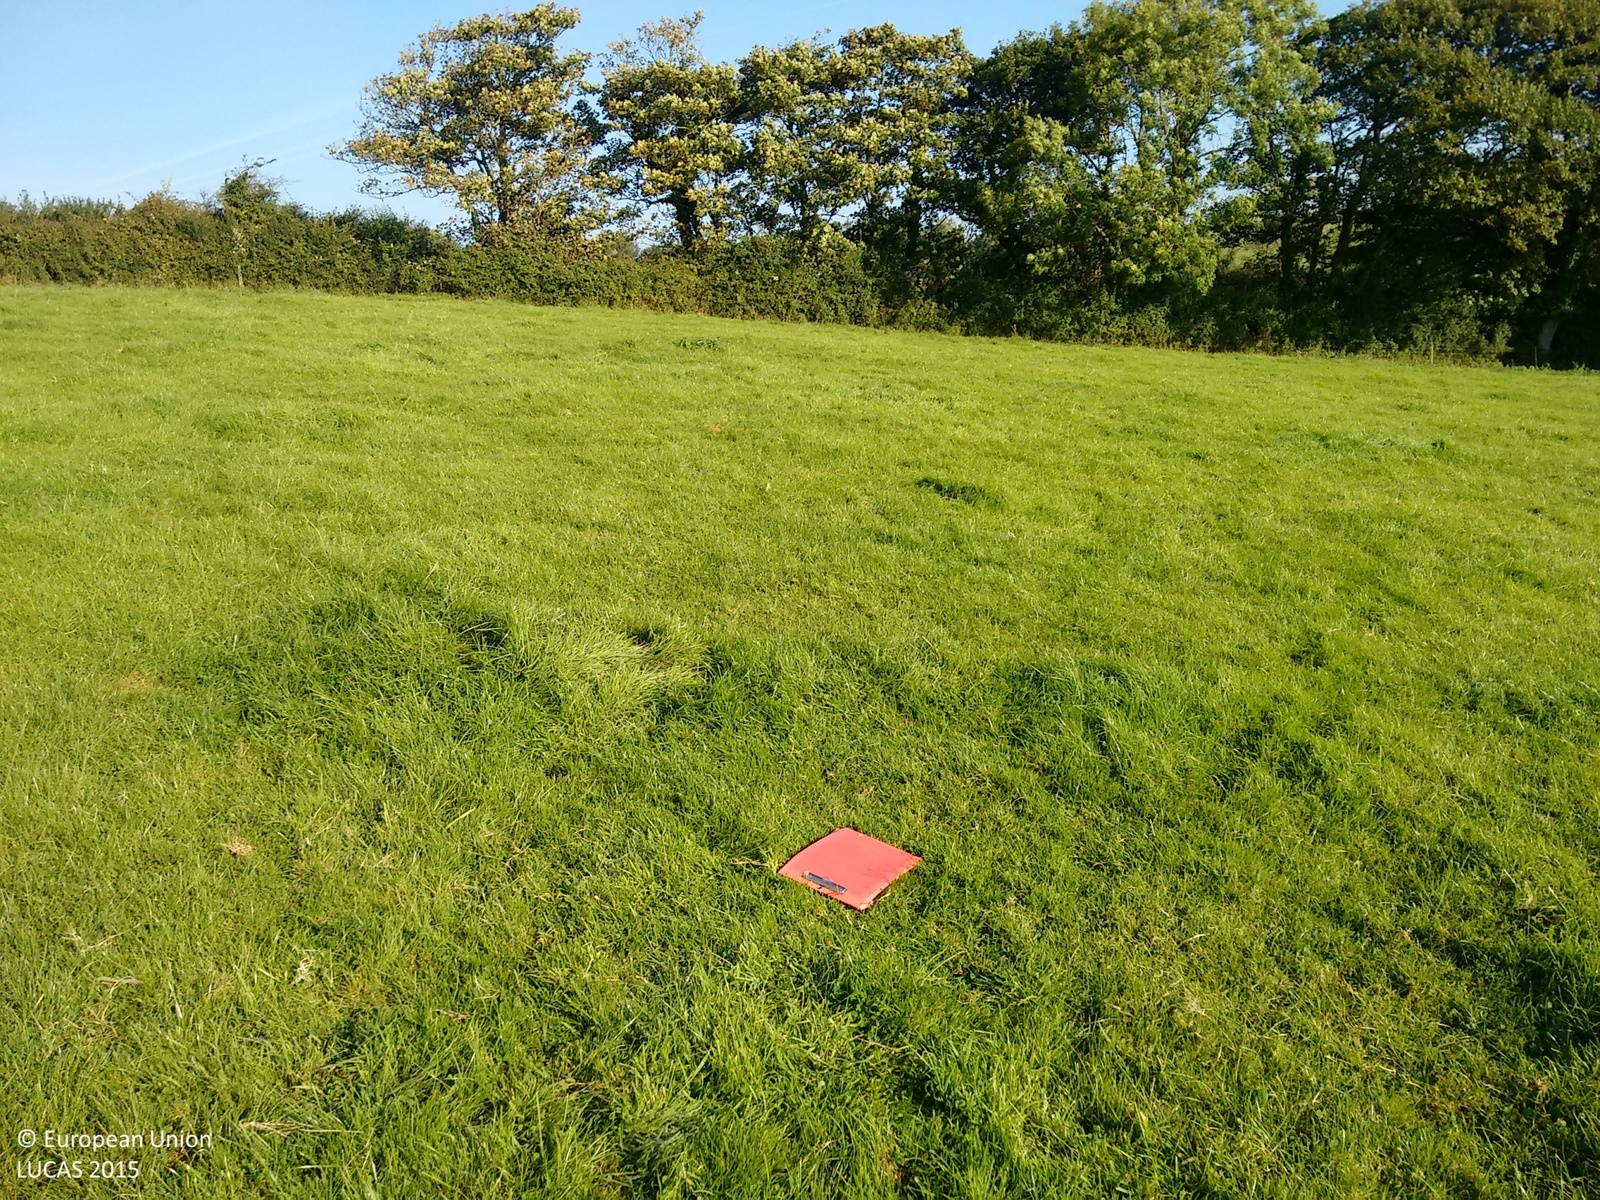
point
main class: Grassland
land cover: Grassland without tree/shrub cover
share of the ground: > 75 %
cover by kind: herbaceous plants 100 %
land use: Agriculture (excluding fallow land and kitchen gardens)
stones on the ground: < 10 %
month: September
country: GB
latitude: 50.8034
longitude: -4.5075
